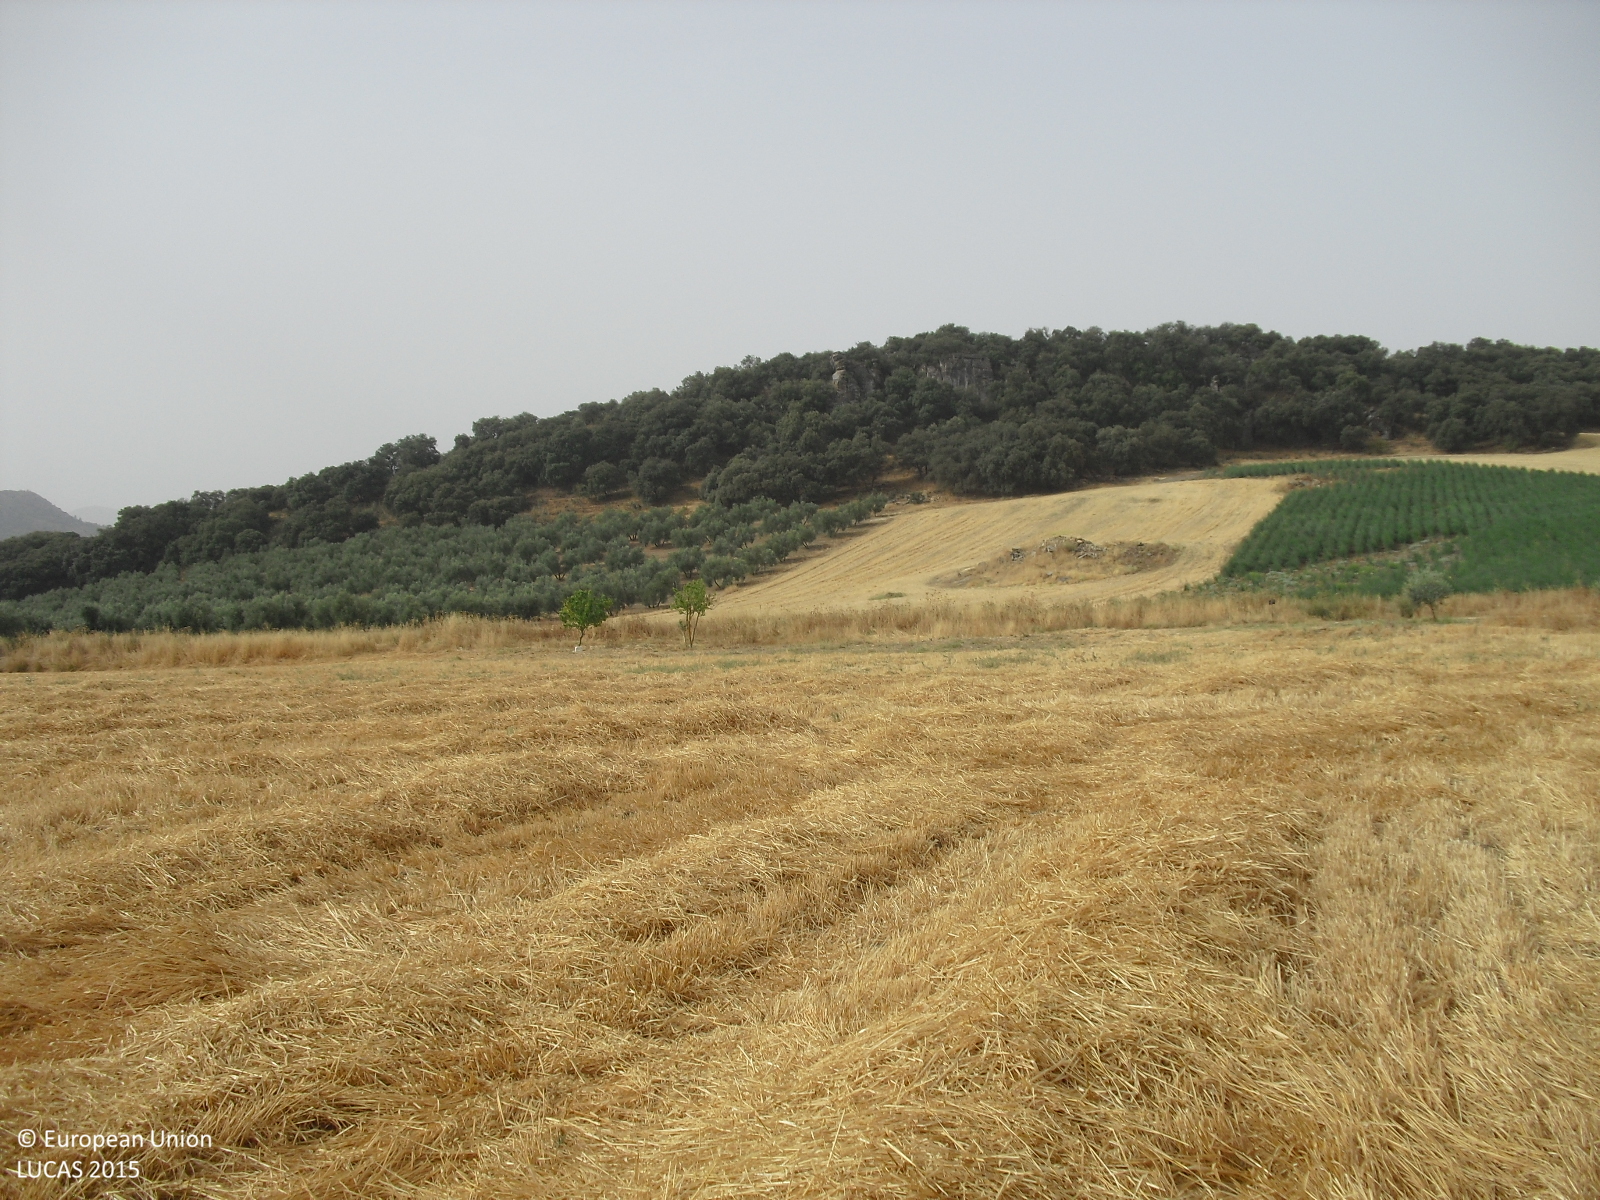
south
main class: Cropland
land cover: Oats
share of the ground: < 10 %
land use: Agriculture (excluding fallow land and kitchen gardens)
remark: Harvested field
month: August
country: ES
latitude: 37.2184
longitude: -4.1384
